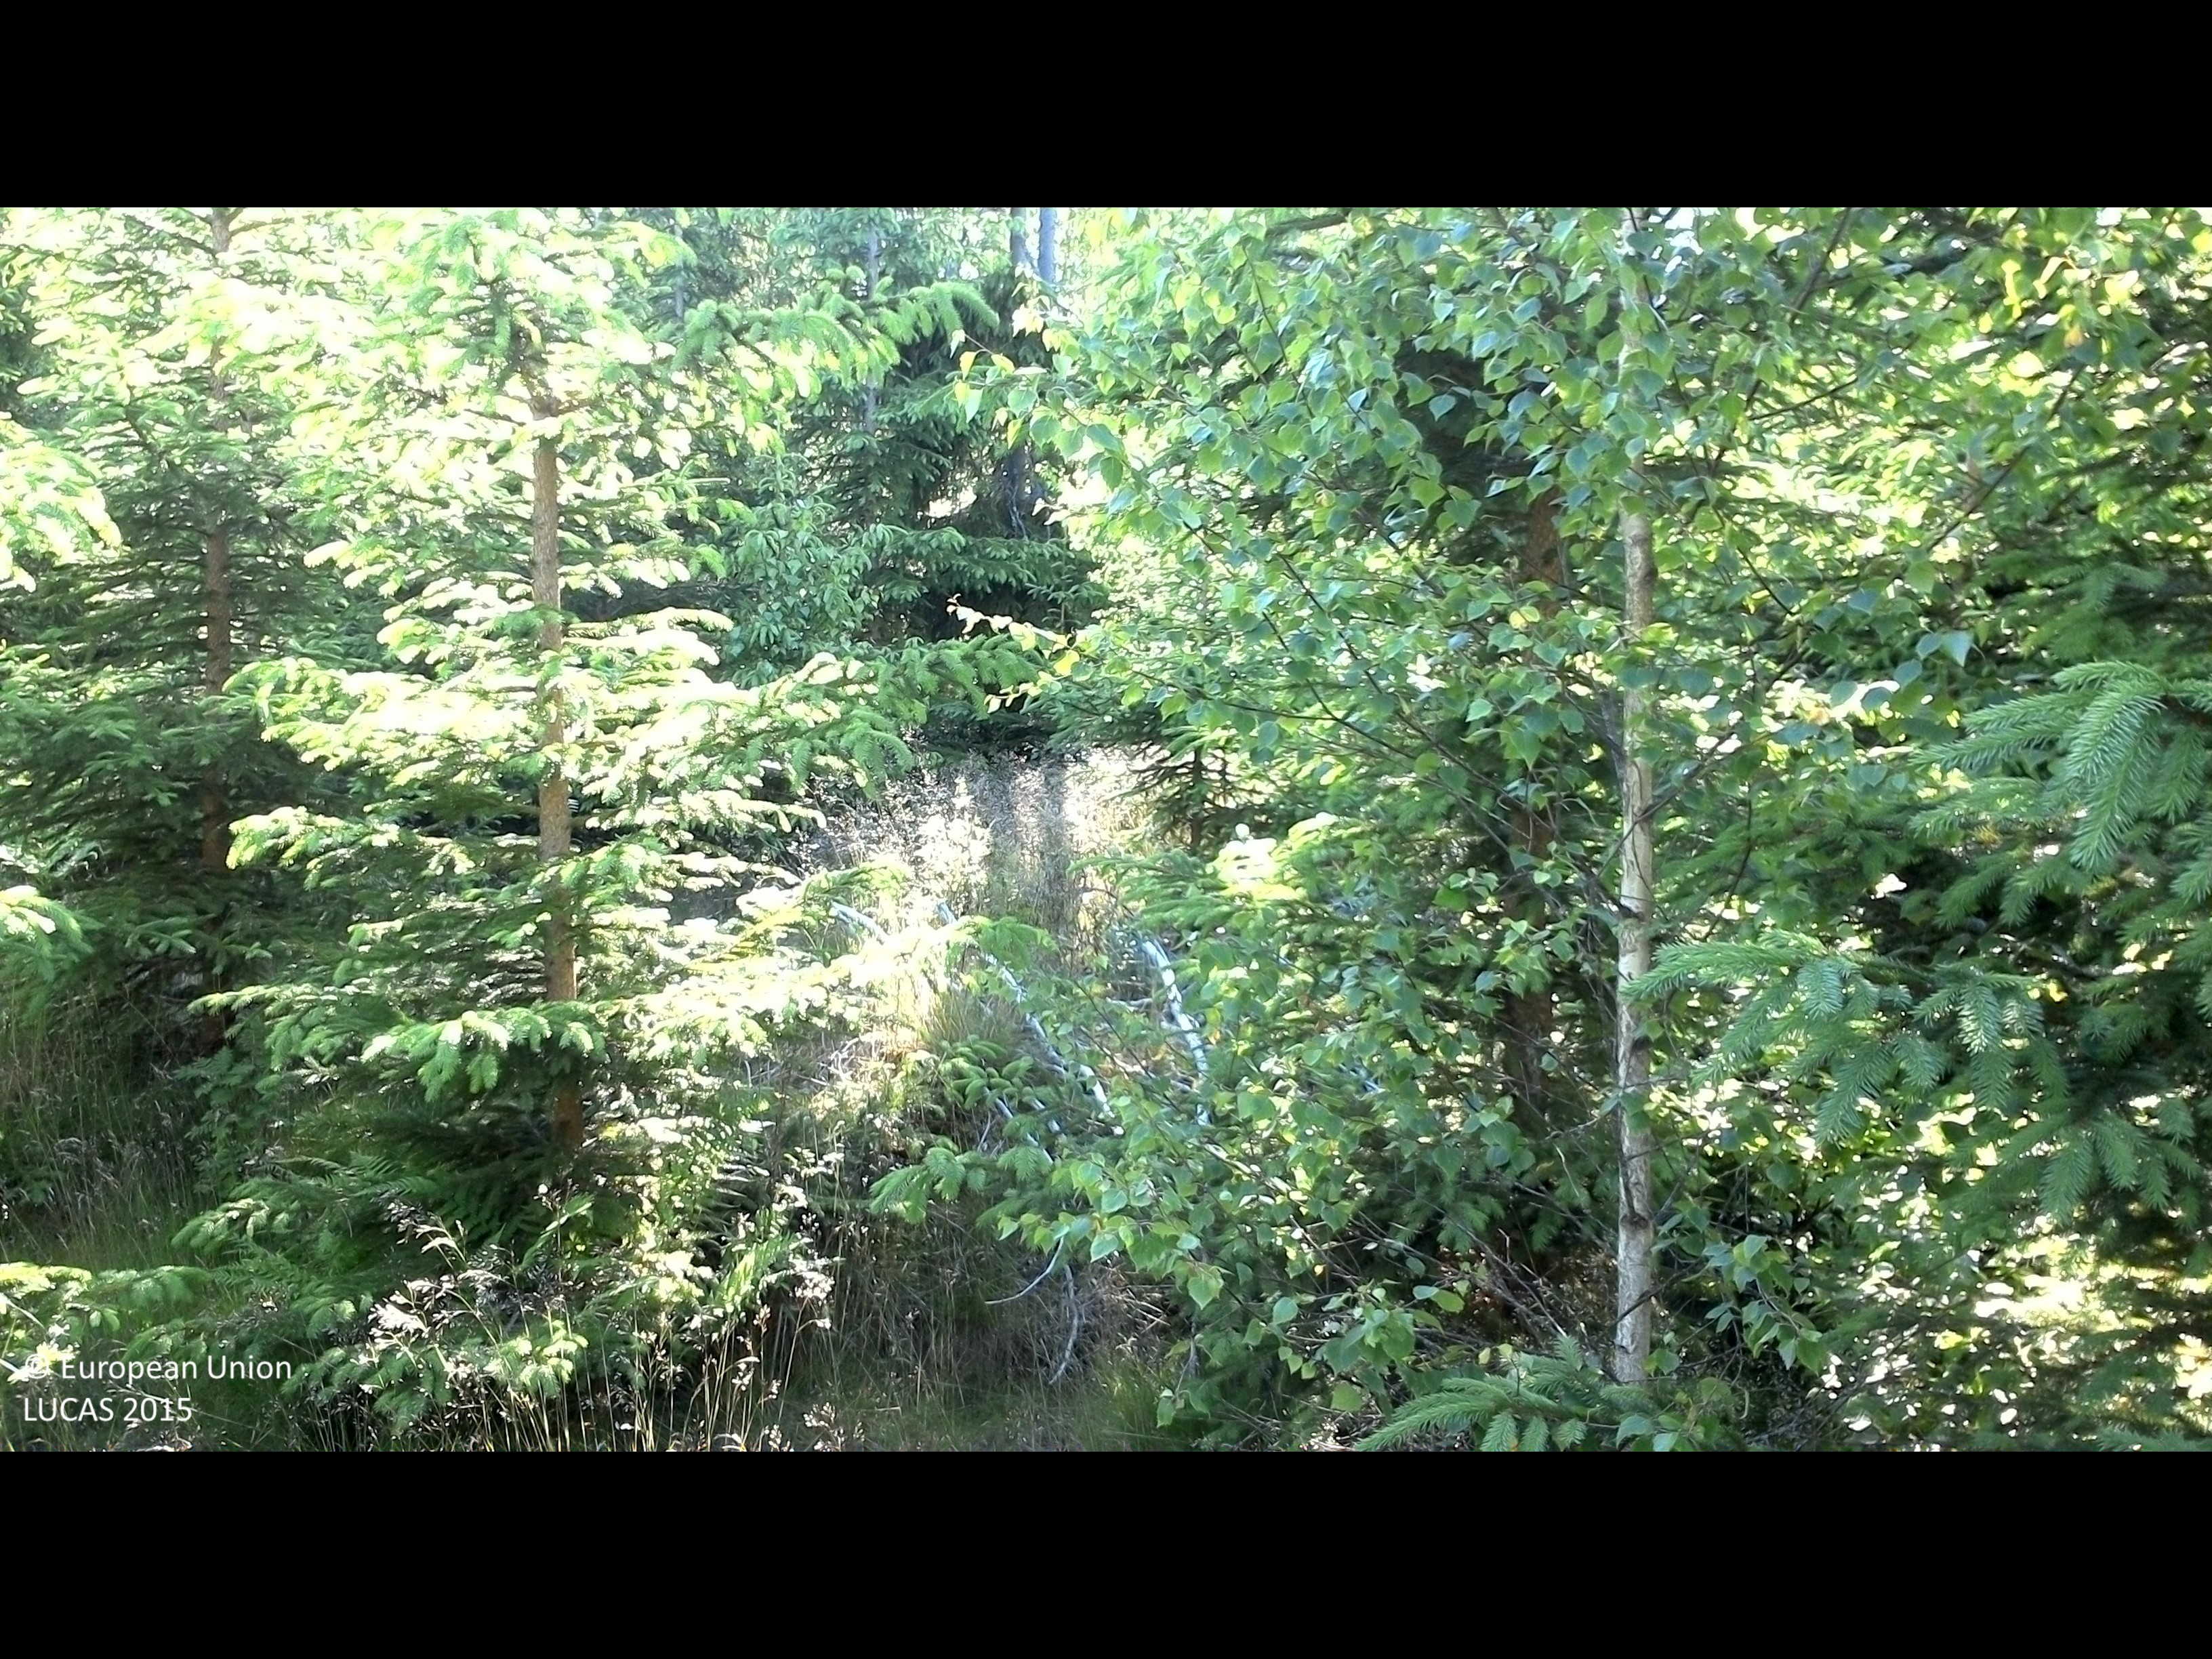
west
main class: Woodland
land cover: Spruce dominated mixed woodland
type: boreal forest
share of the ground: 50 - 75 %
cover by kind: coniferous forest trees 50 %, broadleaved forest trees 25 %, herbaceous plants 25 %
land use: Forestry
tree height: < 5 m
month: July
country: SE
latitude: 56.5652
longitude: 14.8309
